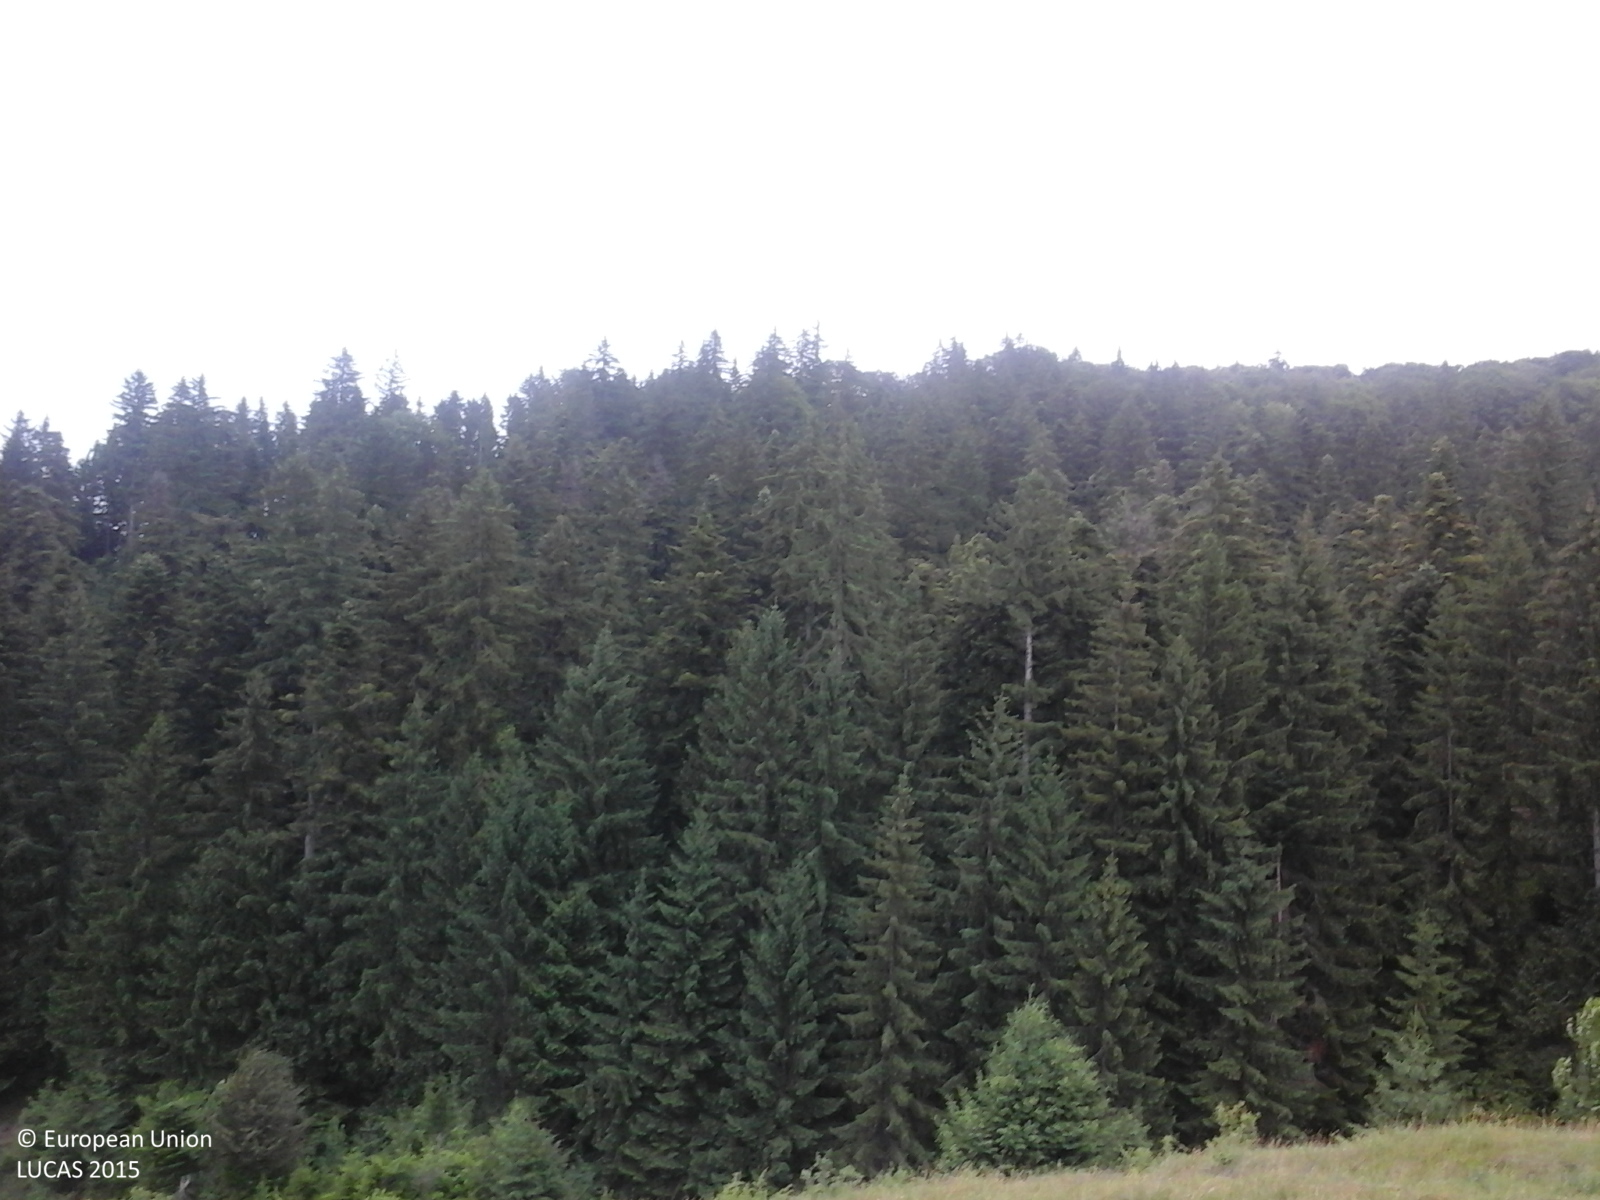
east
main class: Grassland
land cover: Grassland without tree/shrub cover
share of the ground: > 75 %
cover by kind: herbaceous plants 100 %
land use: Agriculture (excluding fallow land and kitchen gardens)
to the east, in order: Grassland without tree/shrub cover; Tracks; Spruce dominated coniferous woodland
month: June
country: RO
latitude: 47.0917
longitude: 26.2975
